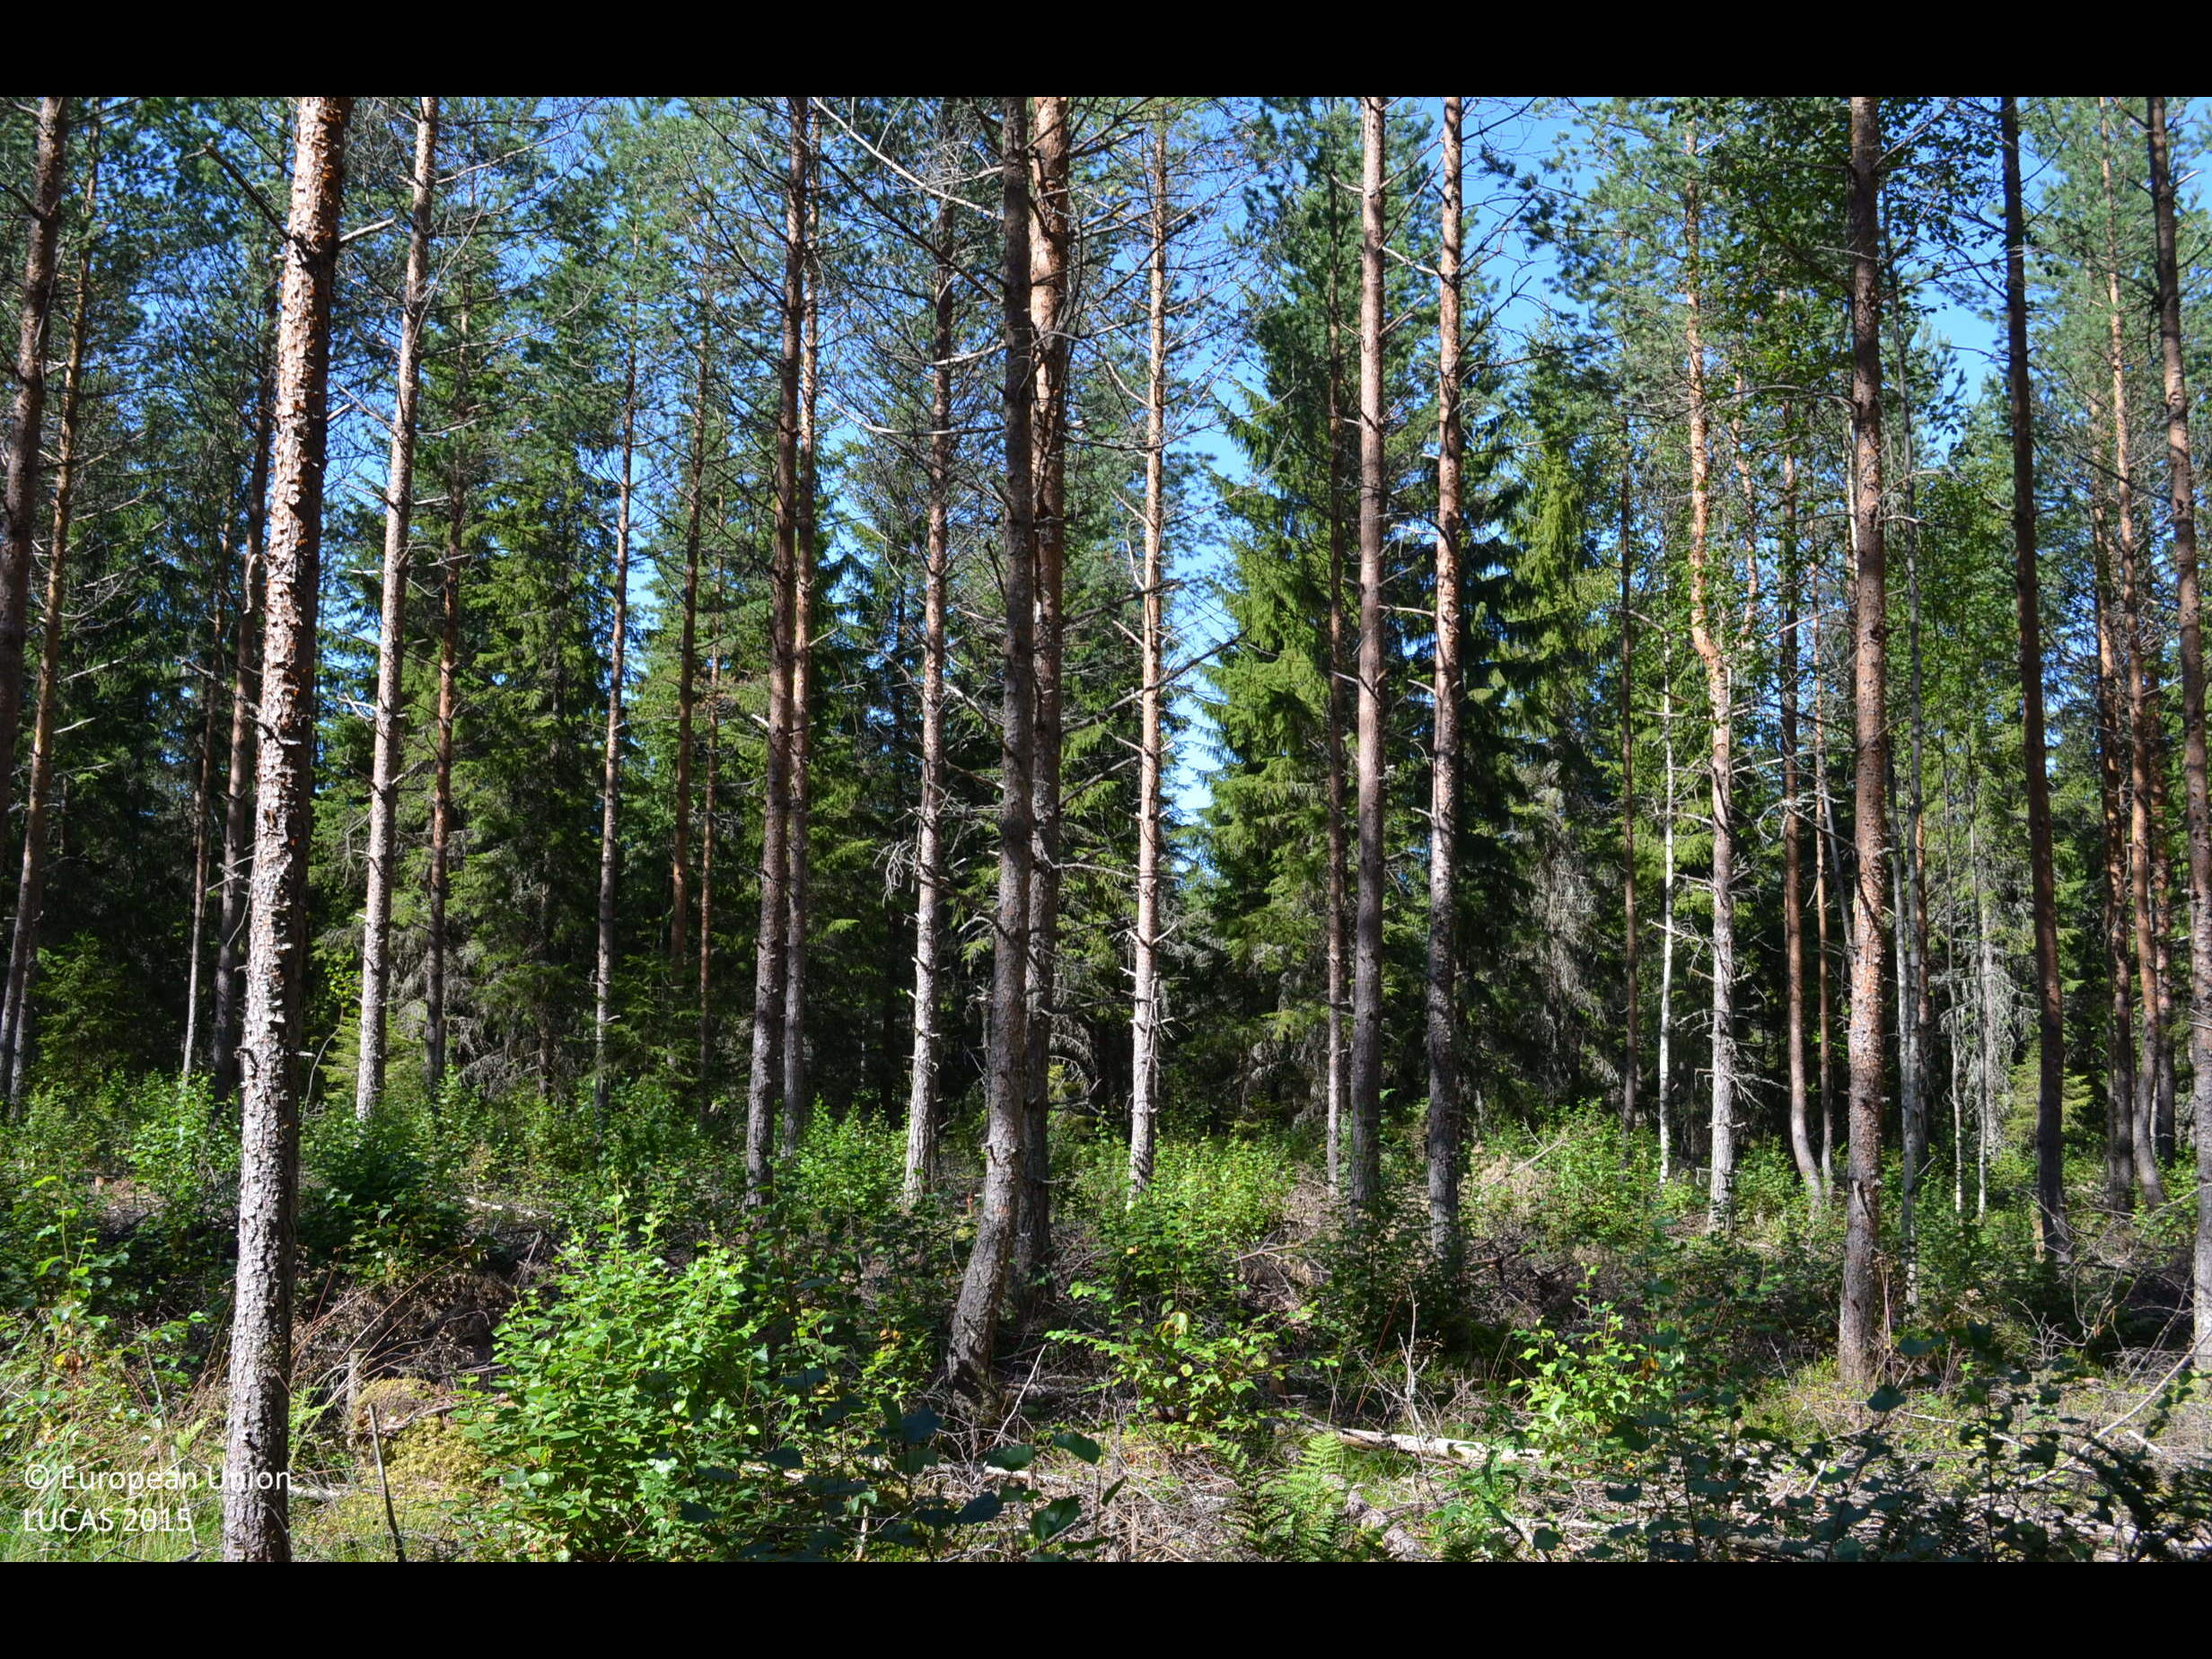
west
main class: Woodland
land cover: Pine dominated coniferous woodland
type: boreal forest
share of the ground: 50 - 75 %
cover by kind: coniferous forest trees 70 %, shrubs 20 %, herbaceous plants 5 %
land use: Forestry
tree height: > 5 m
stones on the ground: < 10 %
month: August
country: FI
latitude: 62.3456
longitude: 24.3211
